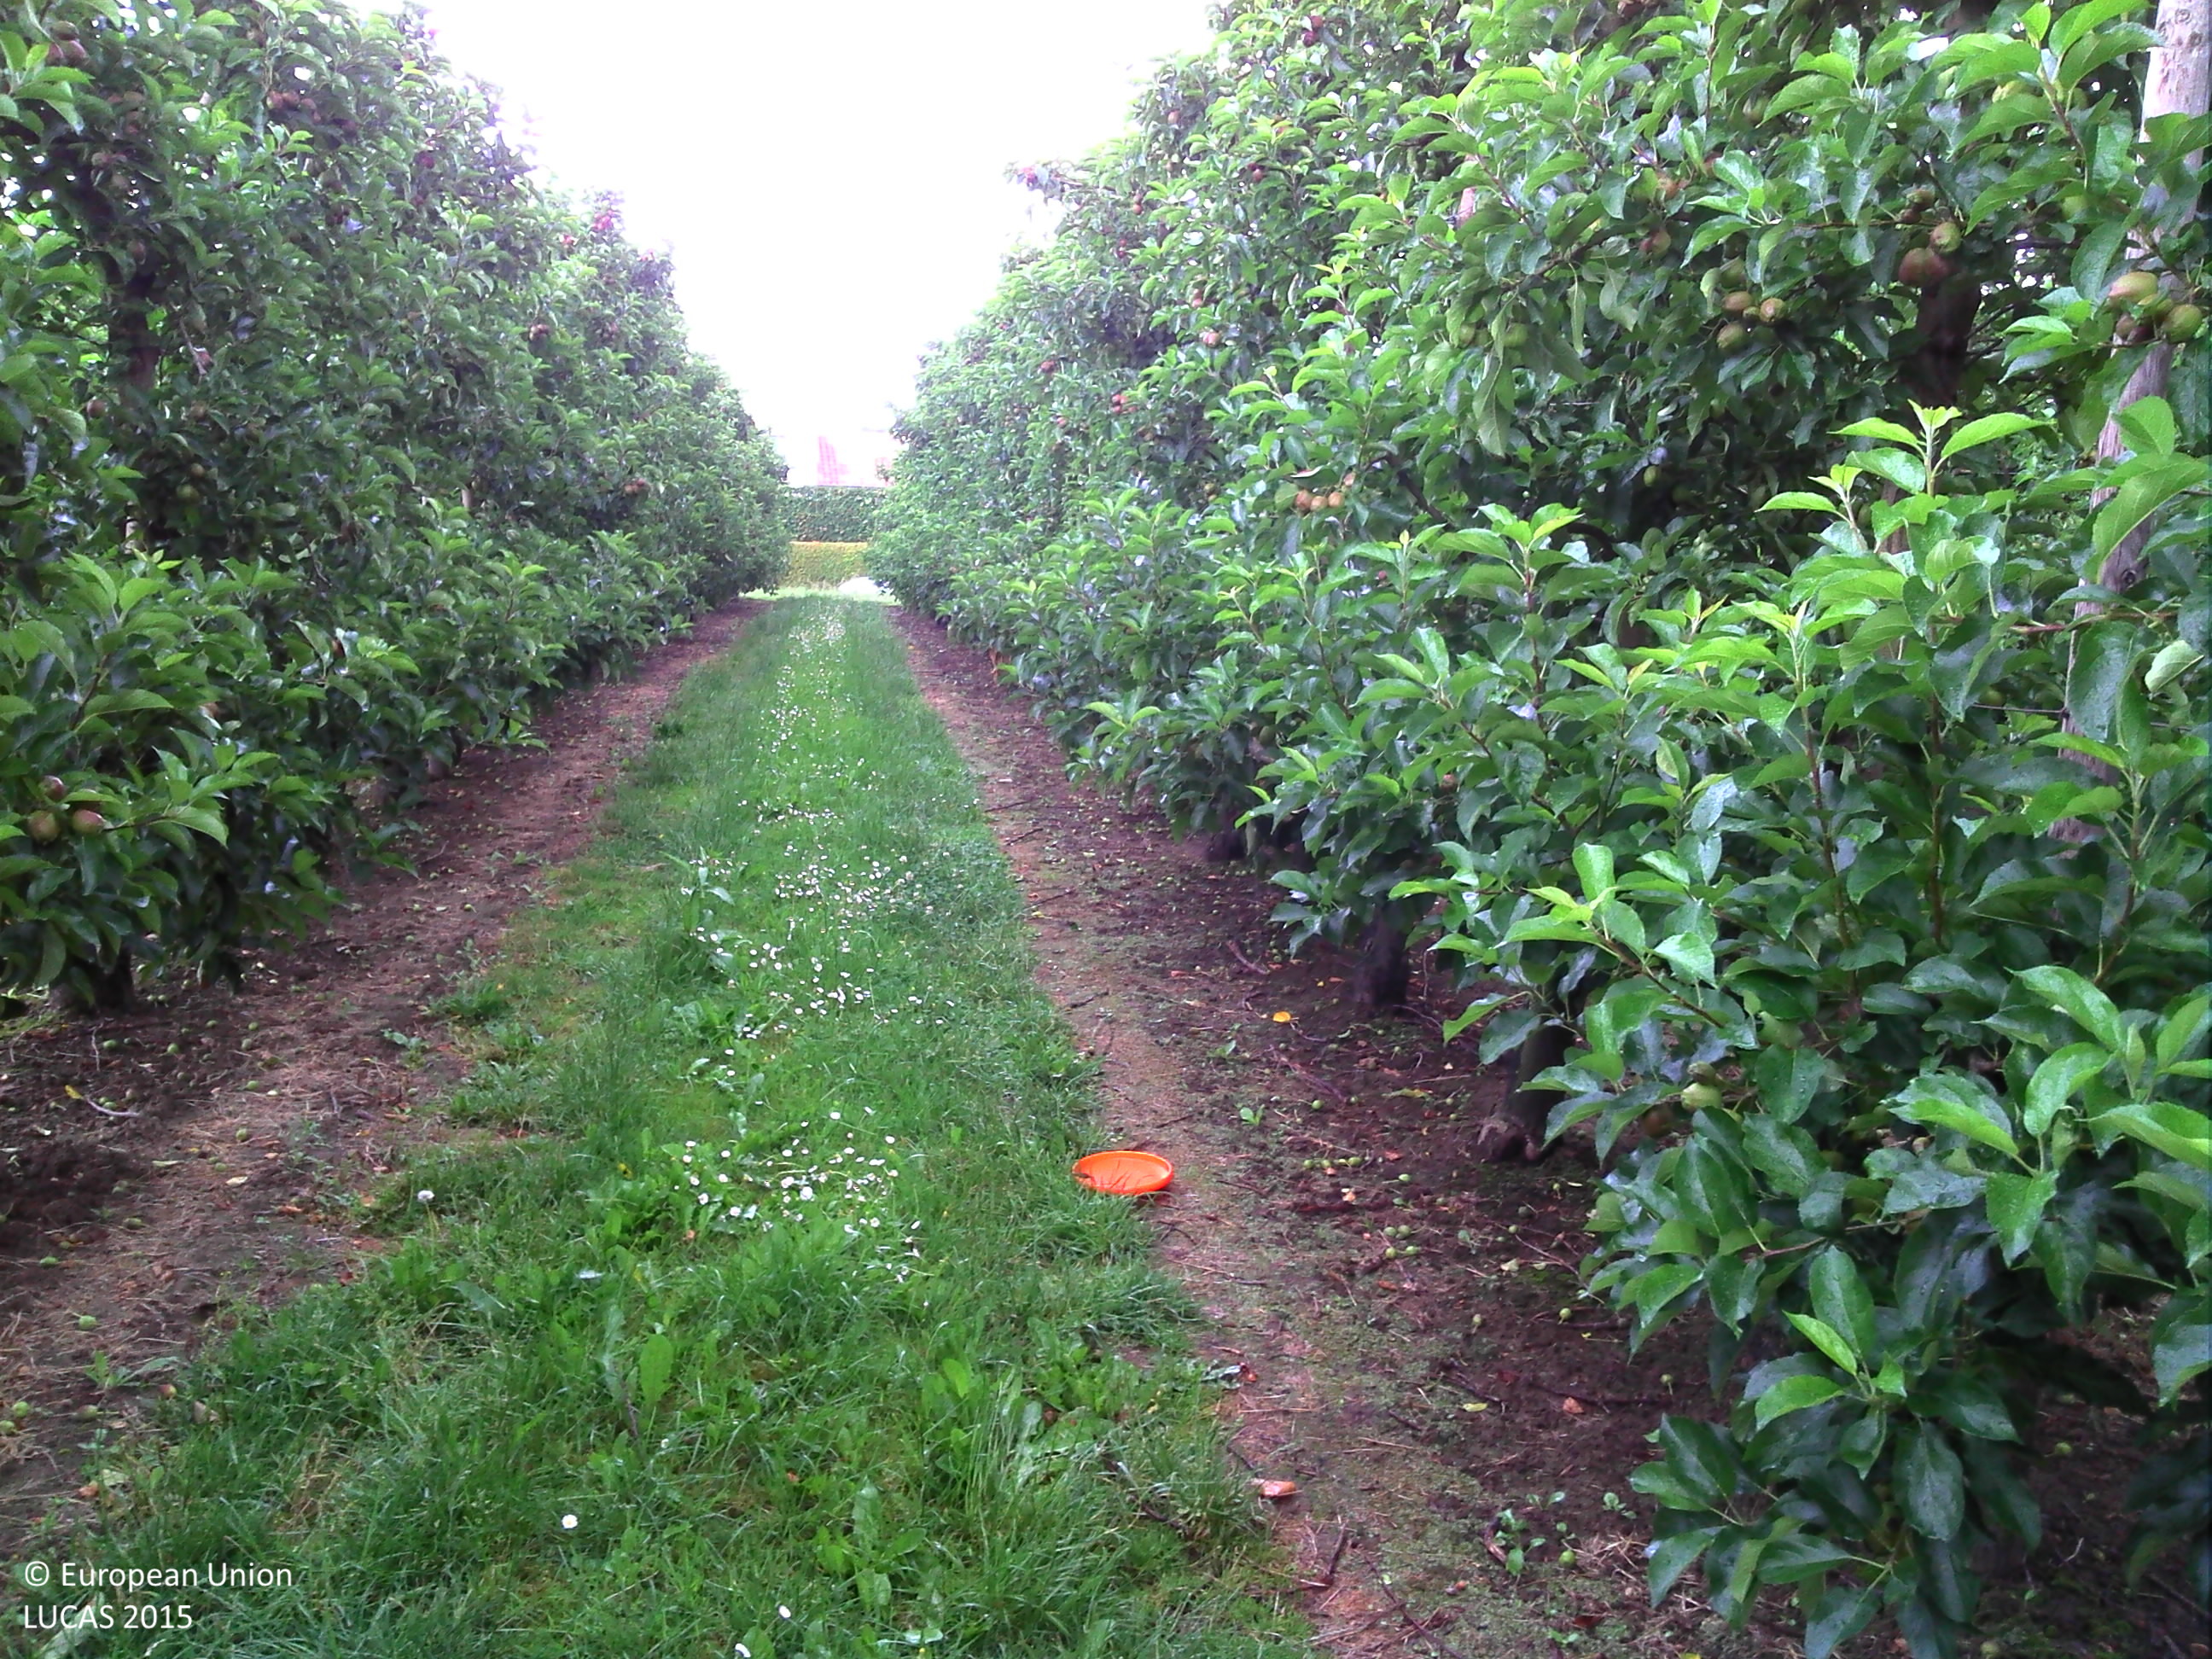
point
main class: Cropland
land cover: Apple fruit
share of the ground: 50 - 75 %
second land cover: Grassland without tree/shrub cover
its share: 25 - 50 %
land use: Agriculture (excluding fallow land and kitchen gardens)
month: June
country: BE
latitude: 50.8964
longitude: 5.2631
